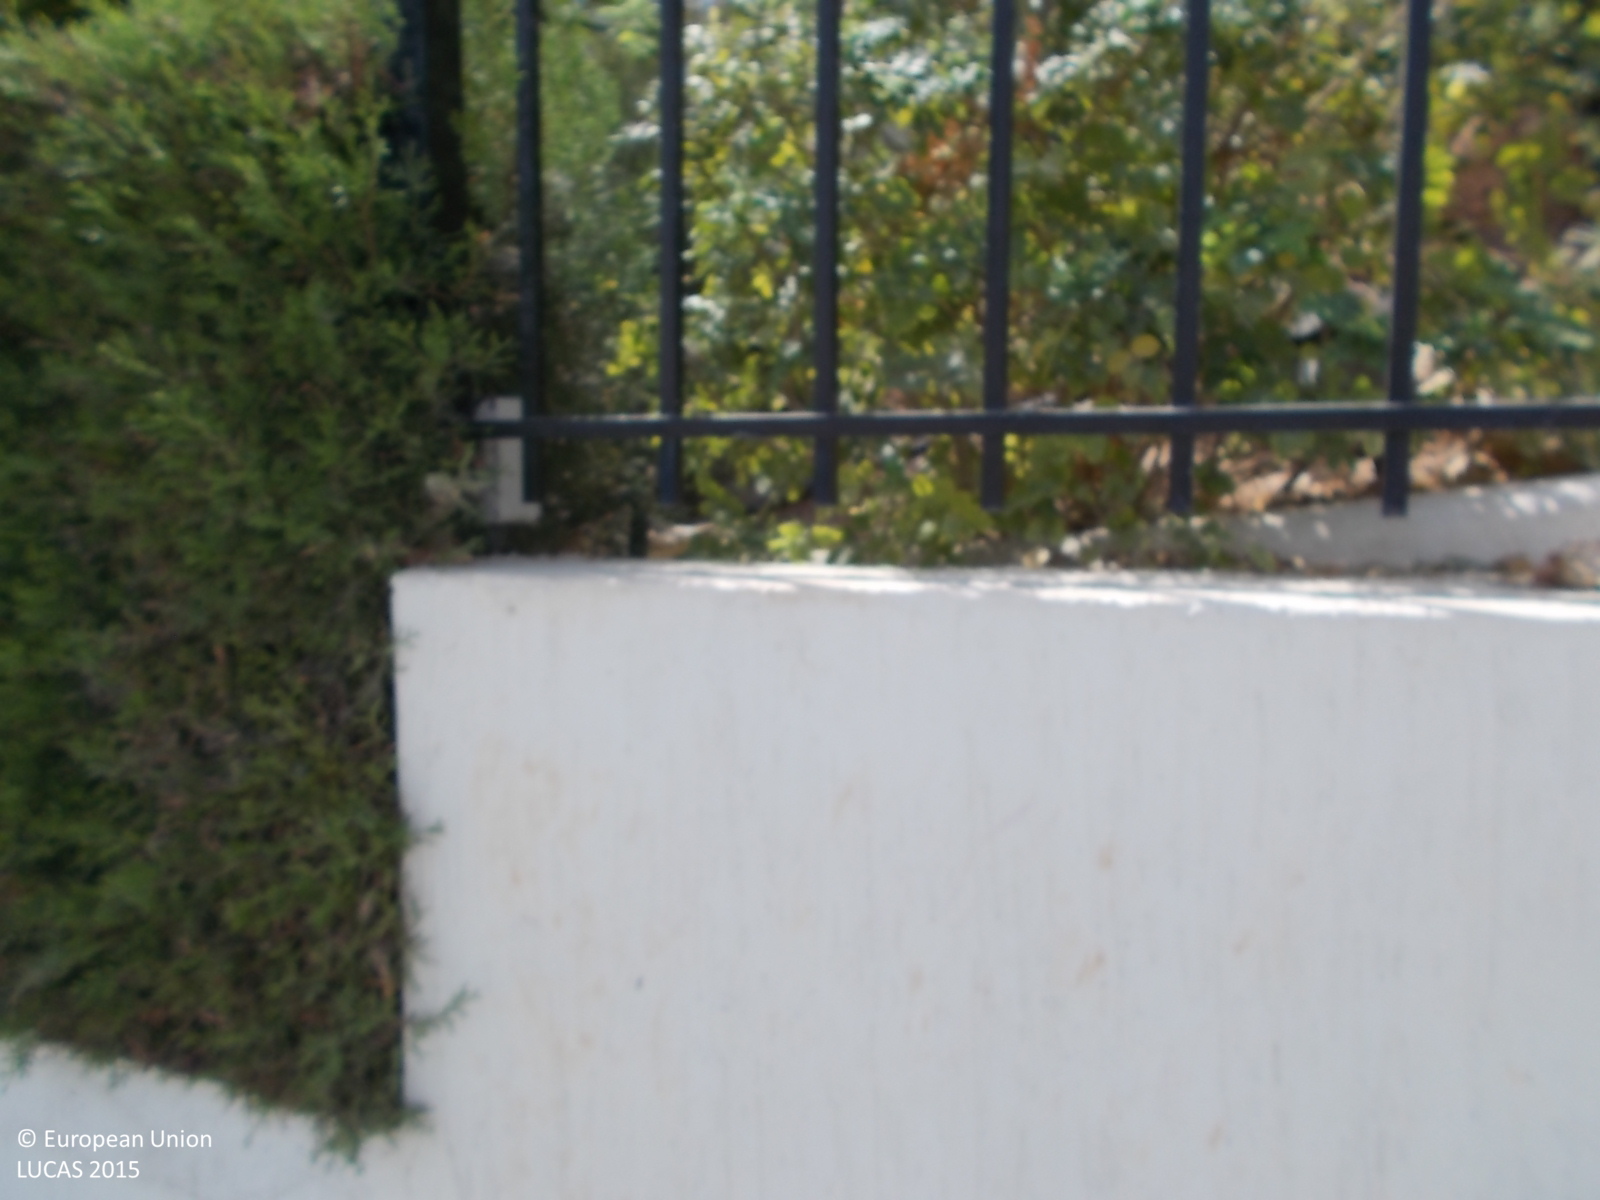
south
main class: Woodland
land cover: Broadleaved woodland
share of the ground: 50 - 75 %
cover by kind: broadleaved forest trees 70 %, unconsolidated bare surface 20 %, consolidated bare surface 10 %
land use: Residential
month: April
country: CY
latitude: 34.7101
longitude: 33.1078
